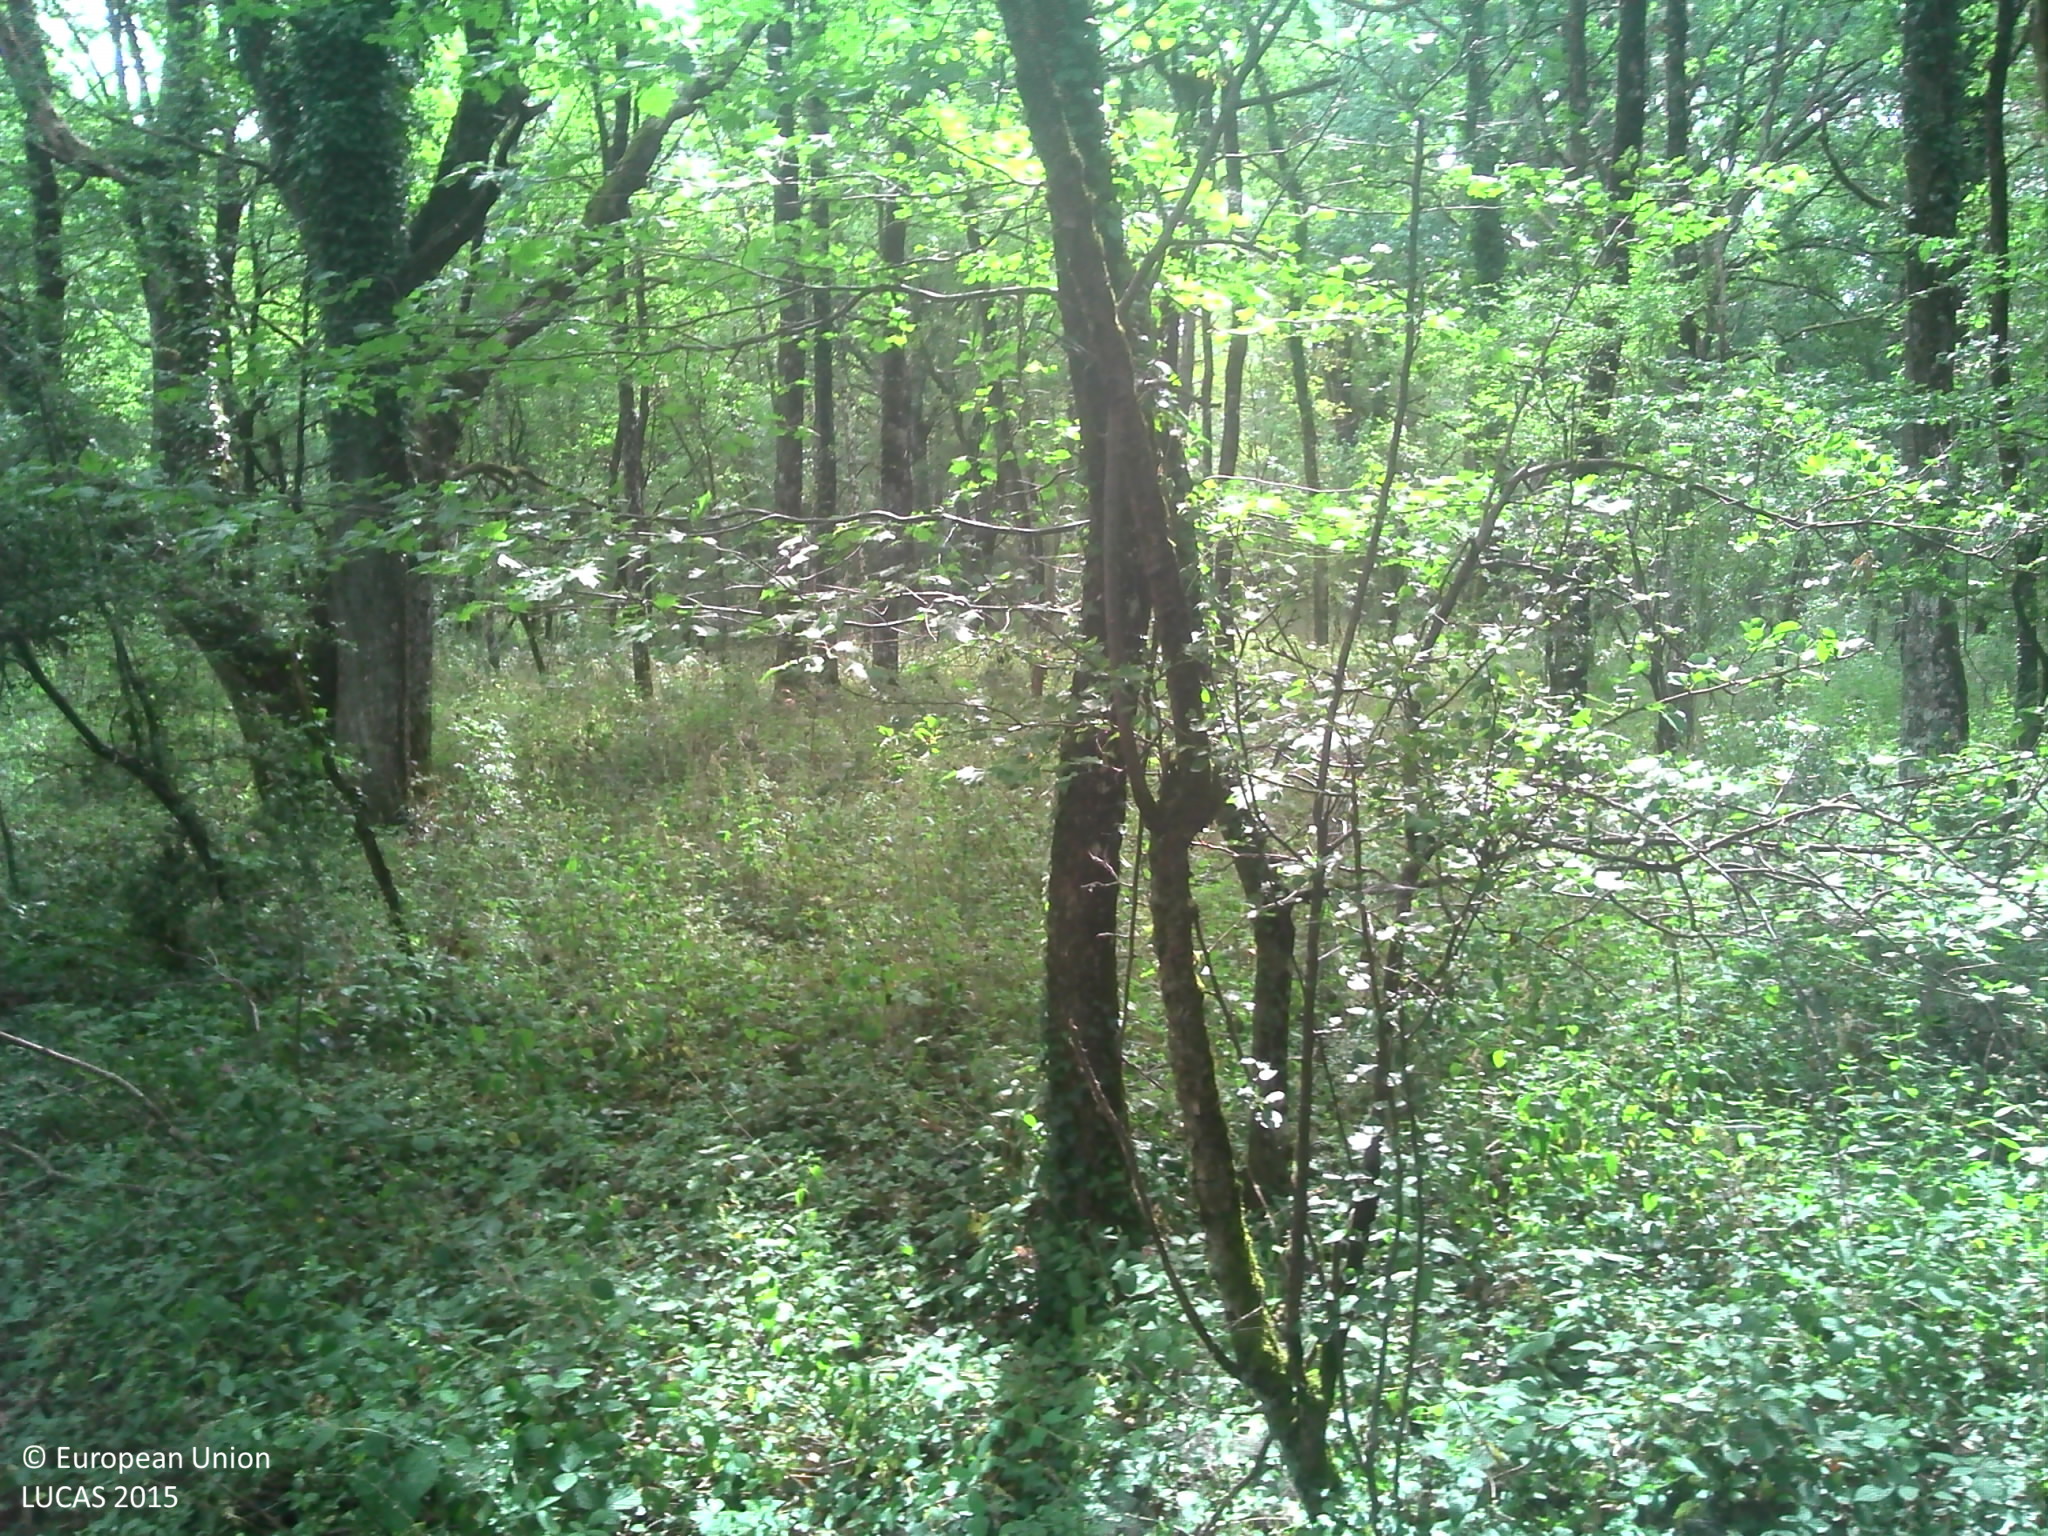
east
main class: Woodland
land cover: Broadleaved woodland
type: mesophytic deciduous forest
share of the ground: > 75 %
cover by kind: herbaceous plants 40 %, unconsolidated bare surface 40 %, broadleaved forest trees 20 %
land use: Forestry
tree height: > 5 m
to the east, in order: Broadleaved woodland; Peatbogs; Inland fresh water bodies
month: June
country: FR
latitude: 47.3658
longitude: 1.4454
